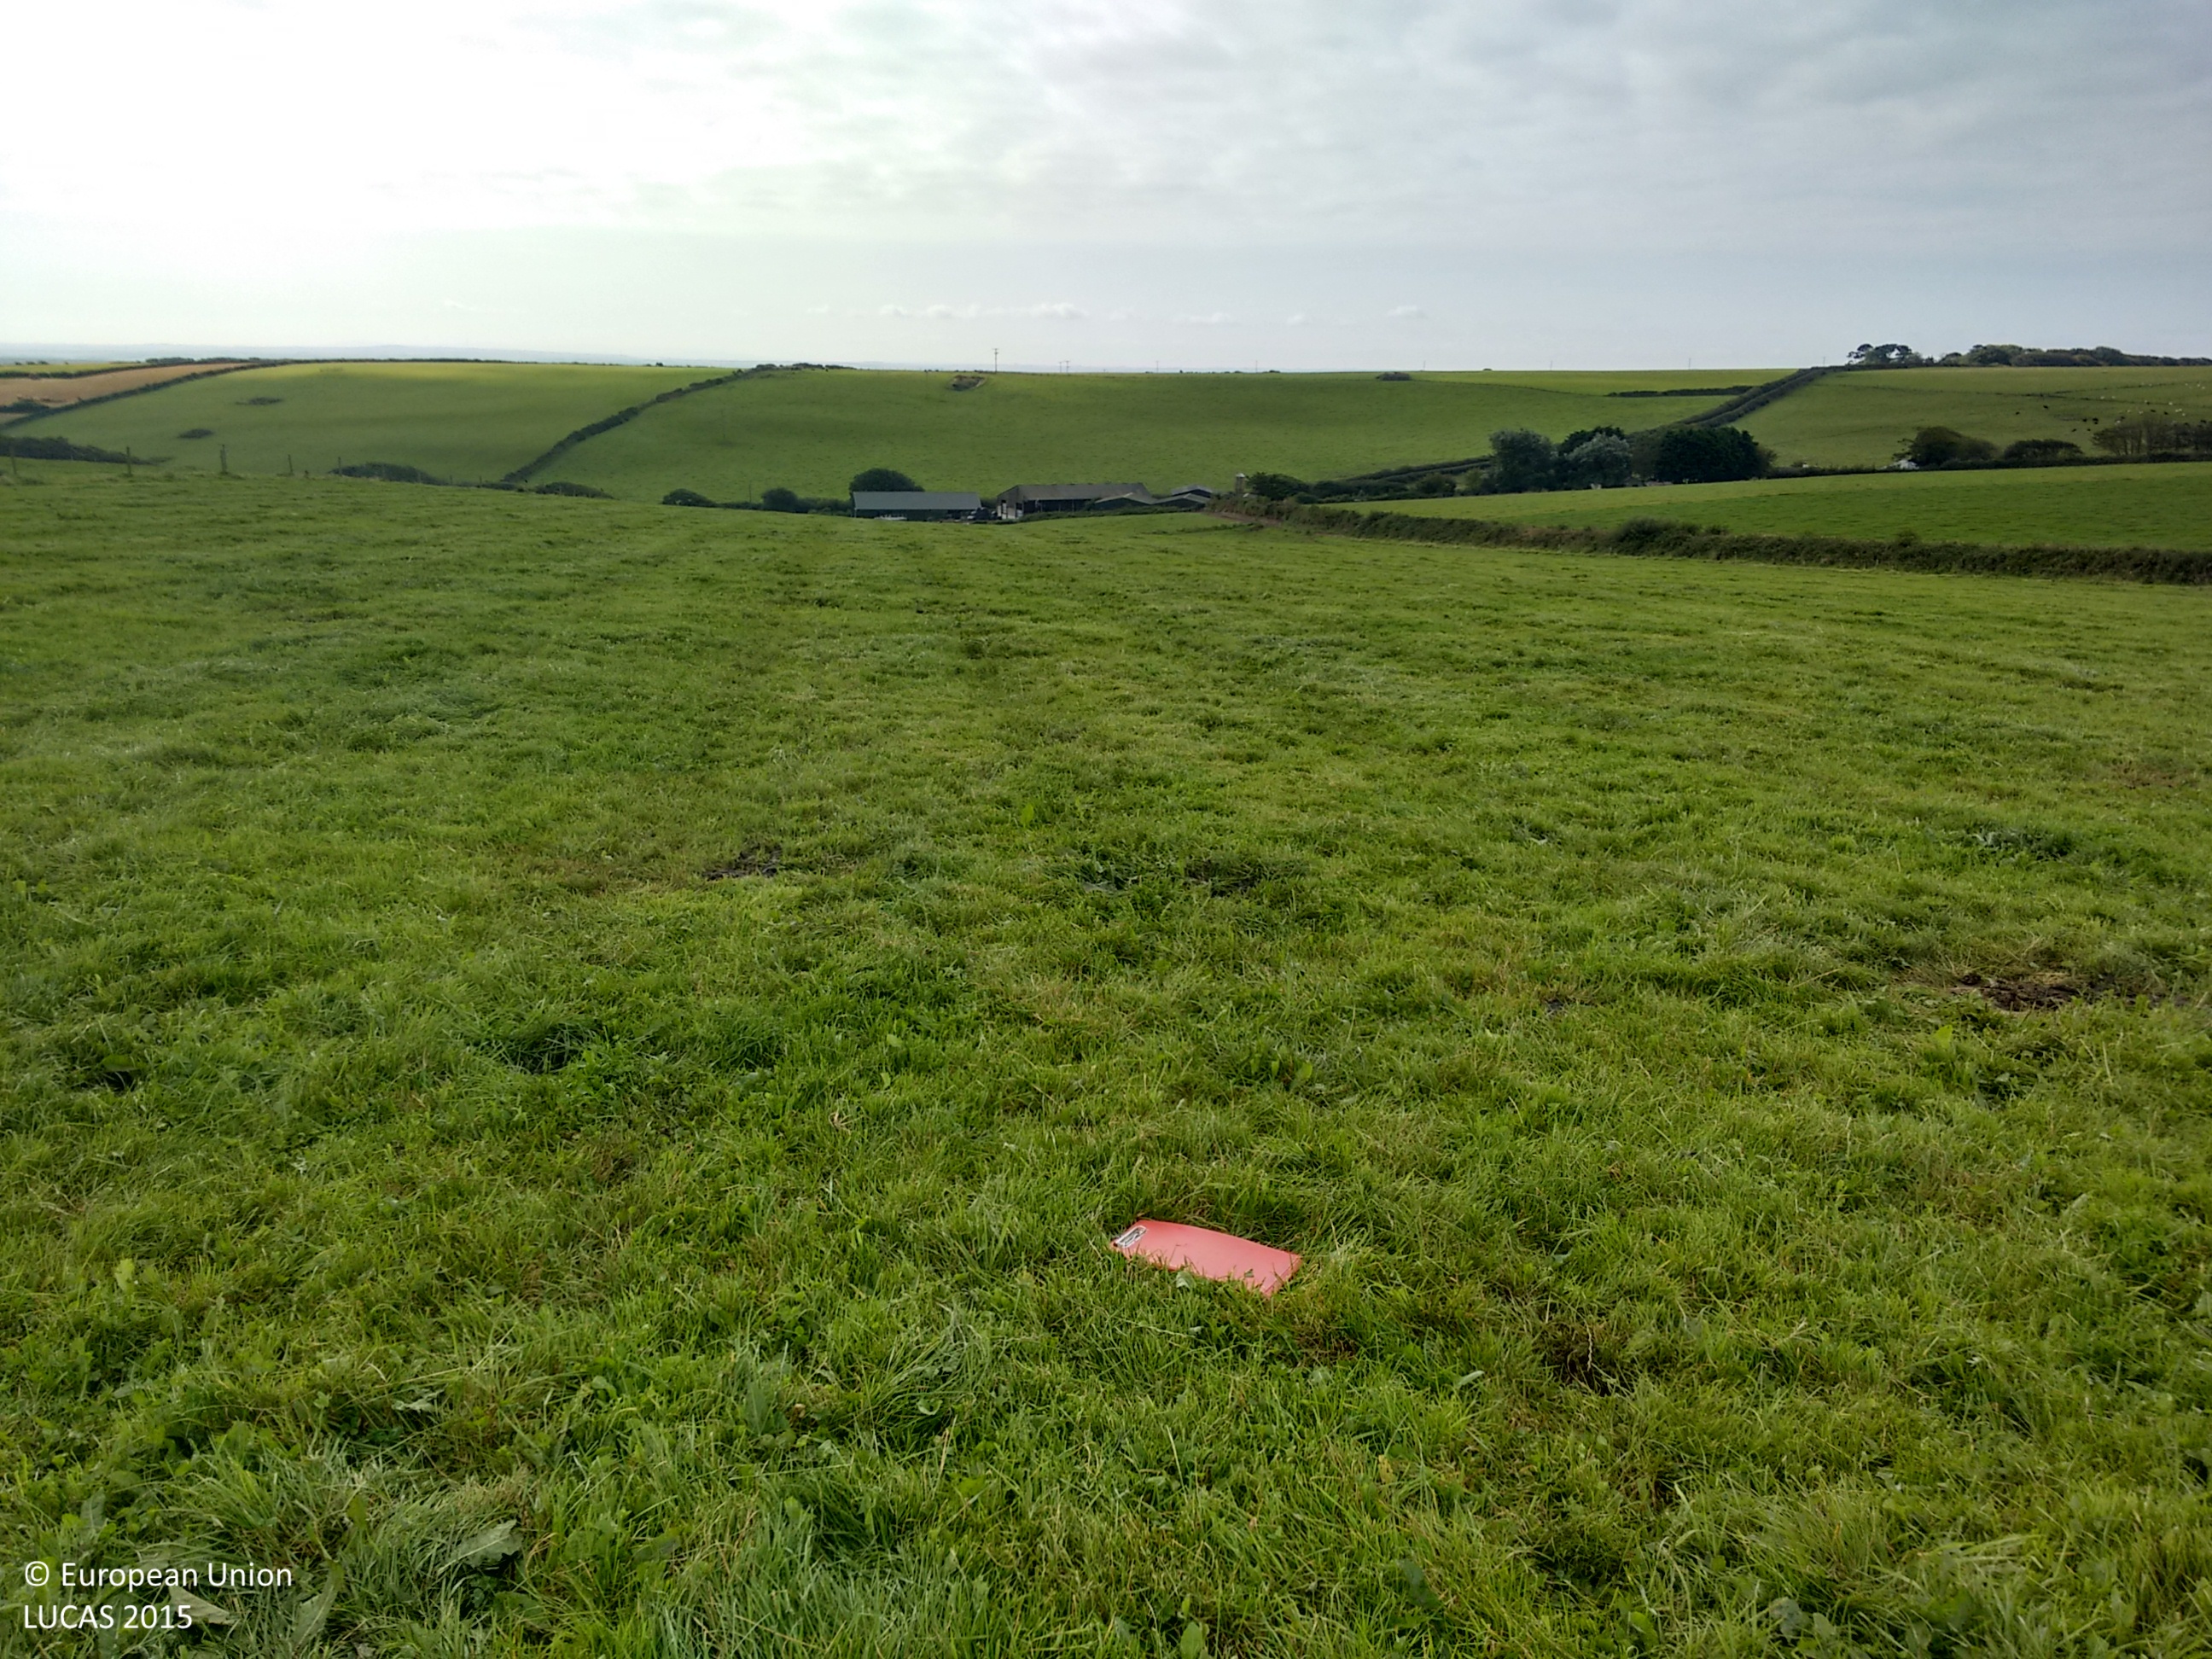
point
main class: Grassland
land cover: Grassland without tree/shrub cover
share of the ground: > 75 %
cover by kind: herbaceous plants 100 %
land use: Agriculture (excluding fallow land and kitchen gardens)
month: September
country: GB
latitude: 51.1549
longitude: -4.1812
